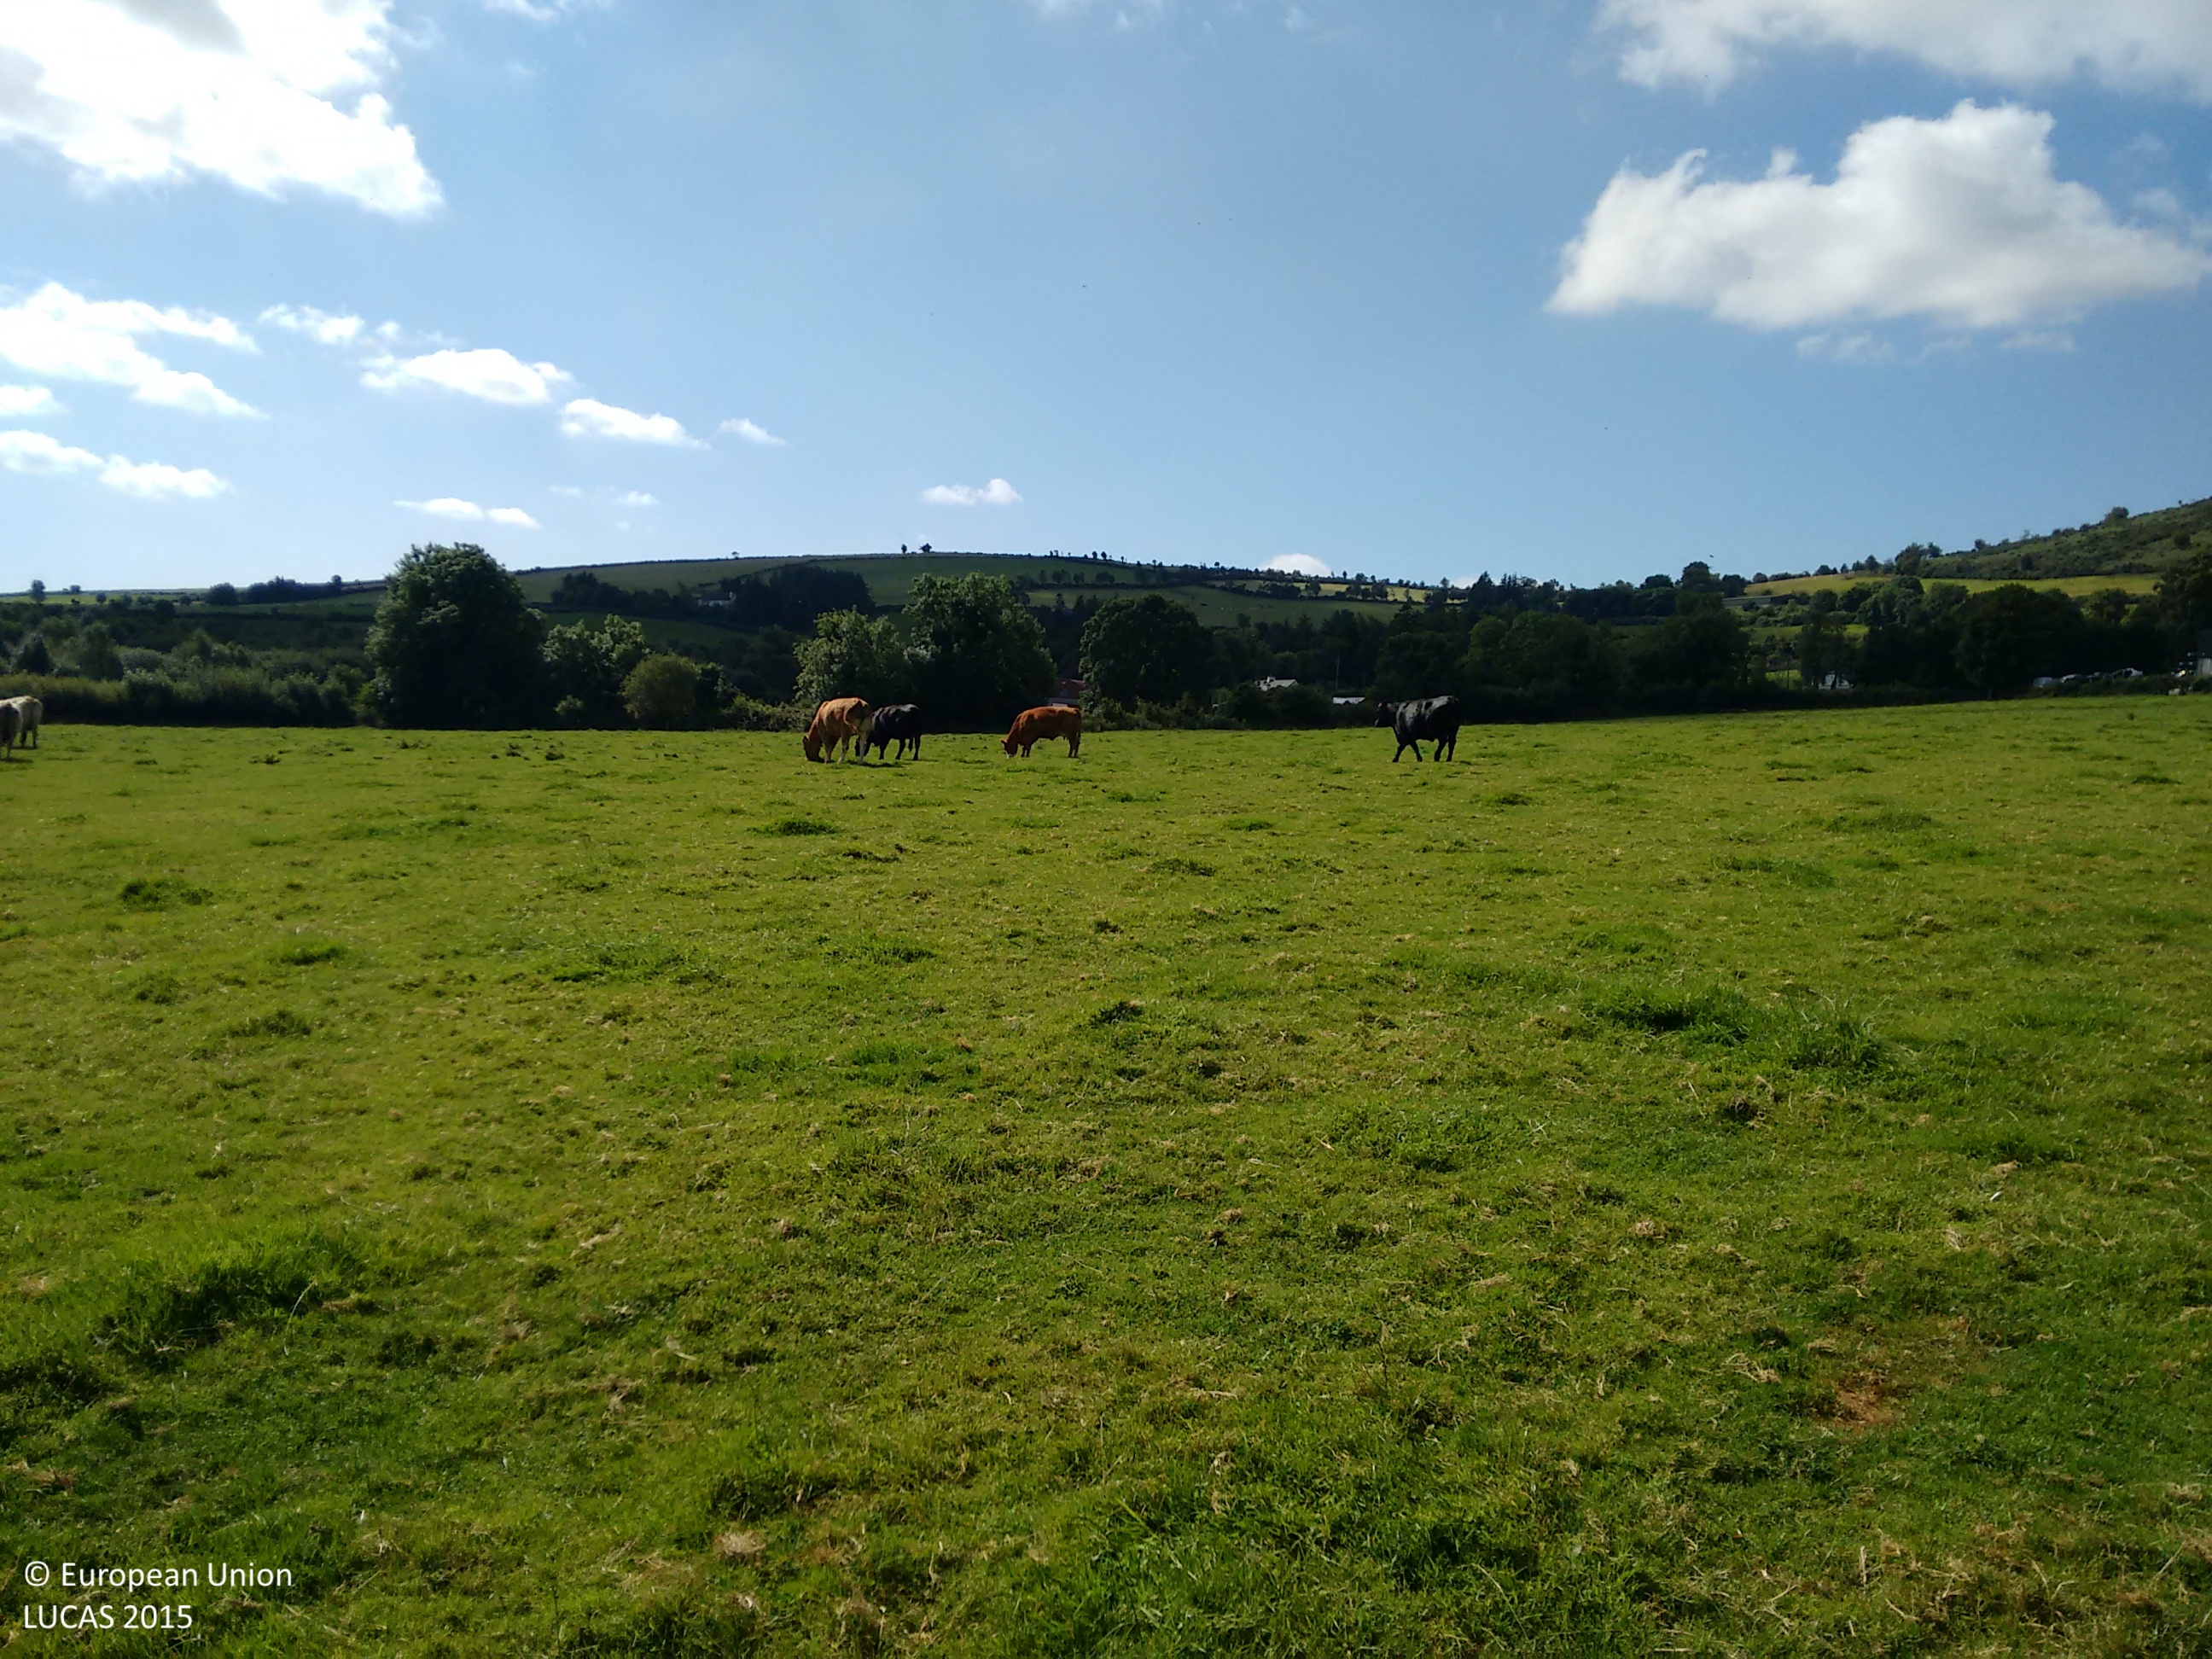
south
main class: Grassland
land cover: Grassland without tree/shrub cover
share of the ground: > 75 %
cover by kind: herbaceous plants 100 %
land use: Agriculture (excluding fallow land and kitchen gardens)
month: August
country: IE
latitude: 52.6349
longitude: -6.6976
